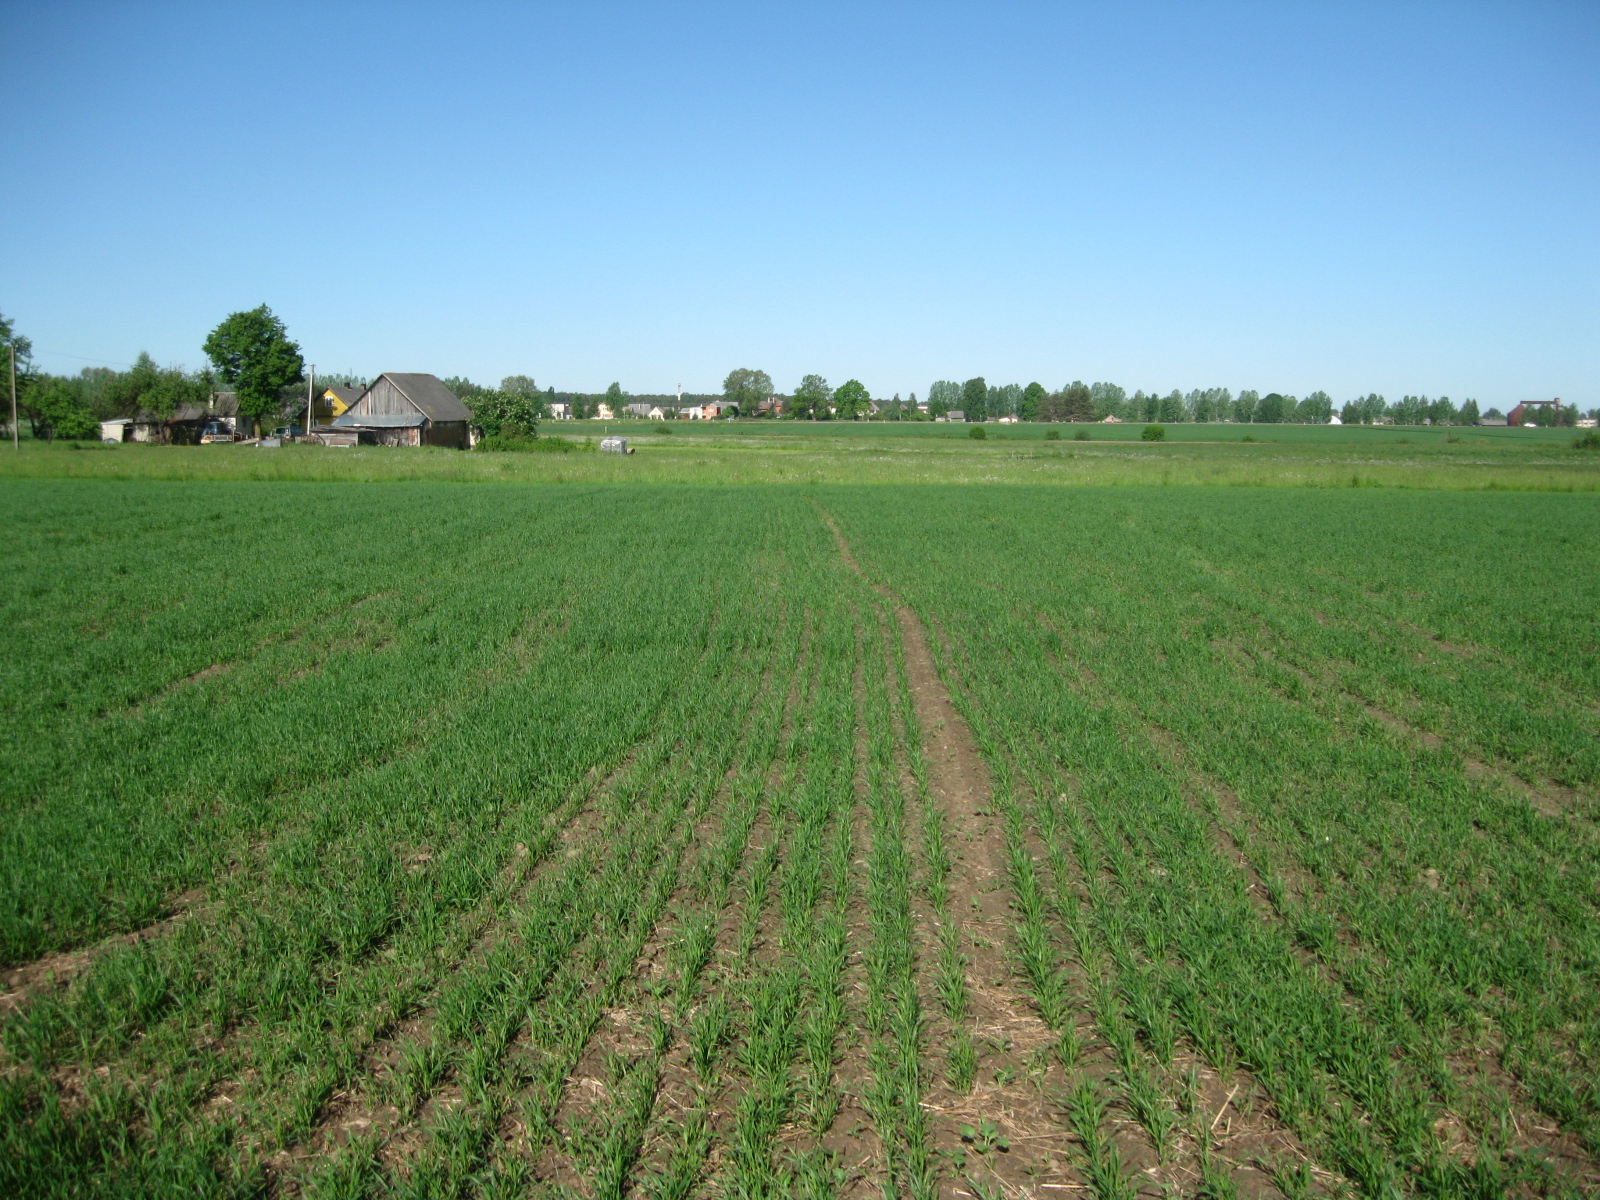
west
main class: Cropland
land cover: Common wheat
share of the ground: 50 - 75 %
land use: Agriculture (excluding fallow land and kitchen gardens)
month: May
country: LT
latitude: 55.8499
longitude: 24.3593
